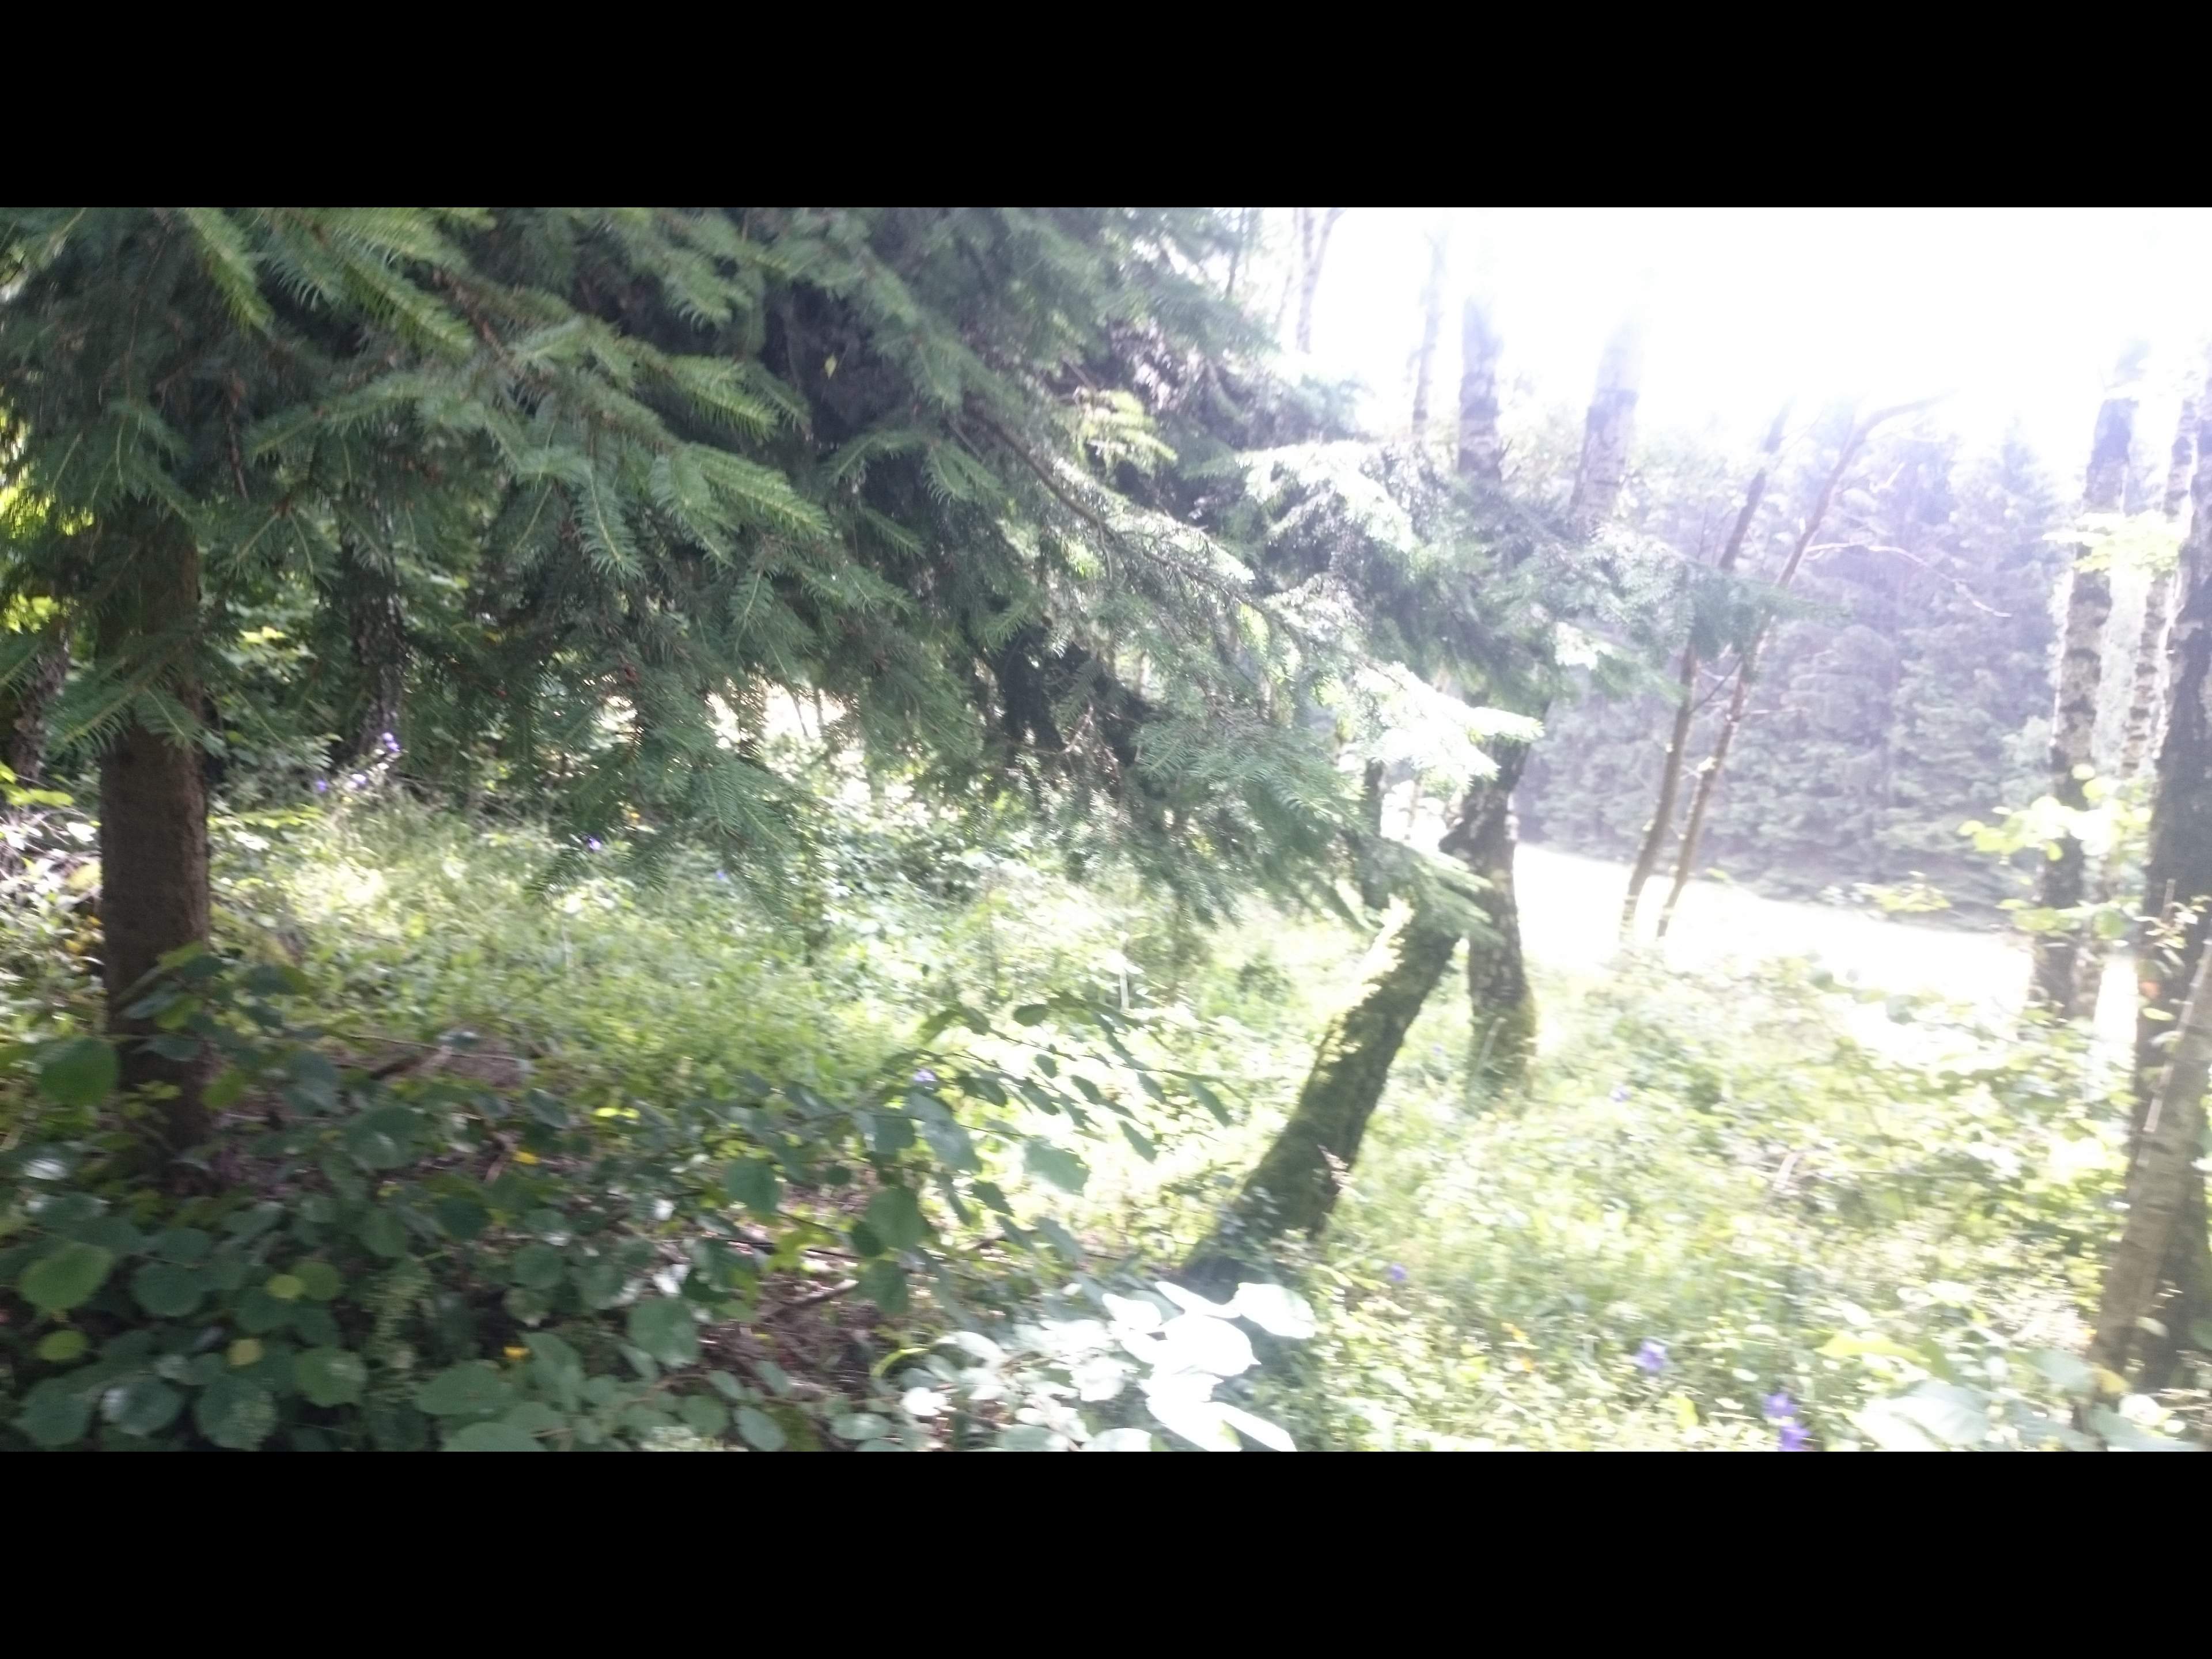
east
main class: Woodland
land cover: Broadleaved woodland
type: non-riverine alder, birch or aspen forest
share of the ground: > 75 %
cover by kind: broadleaved forest trees 80 %, shrubs 10 %, herbaceous plants 10 %
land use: Forestry
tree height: > 5 m
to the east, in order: Broadleaved woodland; Grassland without tree/shrub cover; Spruce dominated mixed woodland; Tracks; Pine dominated mixed woodland; Tracks; Spruce dominated mixed woodland
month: June
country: AT
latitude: 48.6421
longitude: 14.7922
